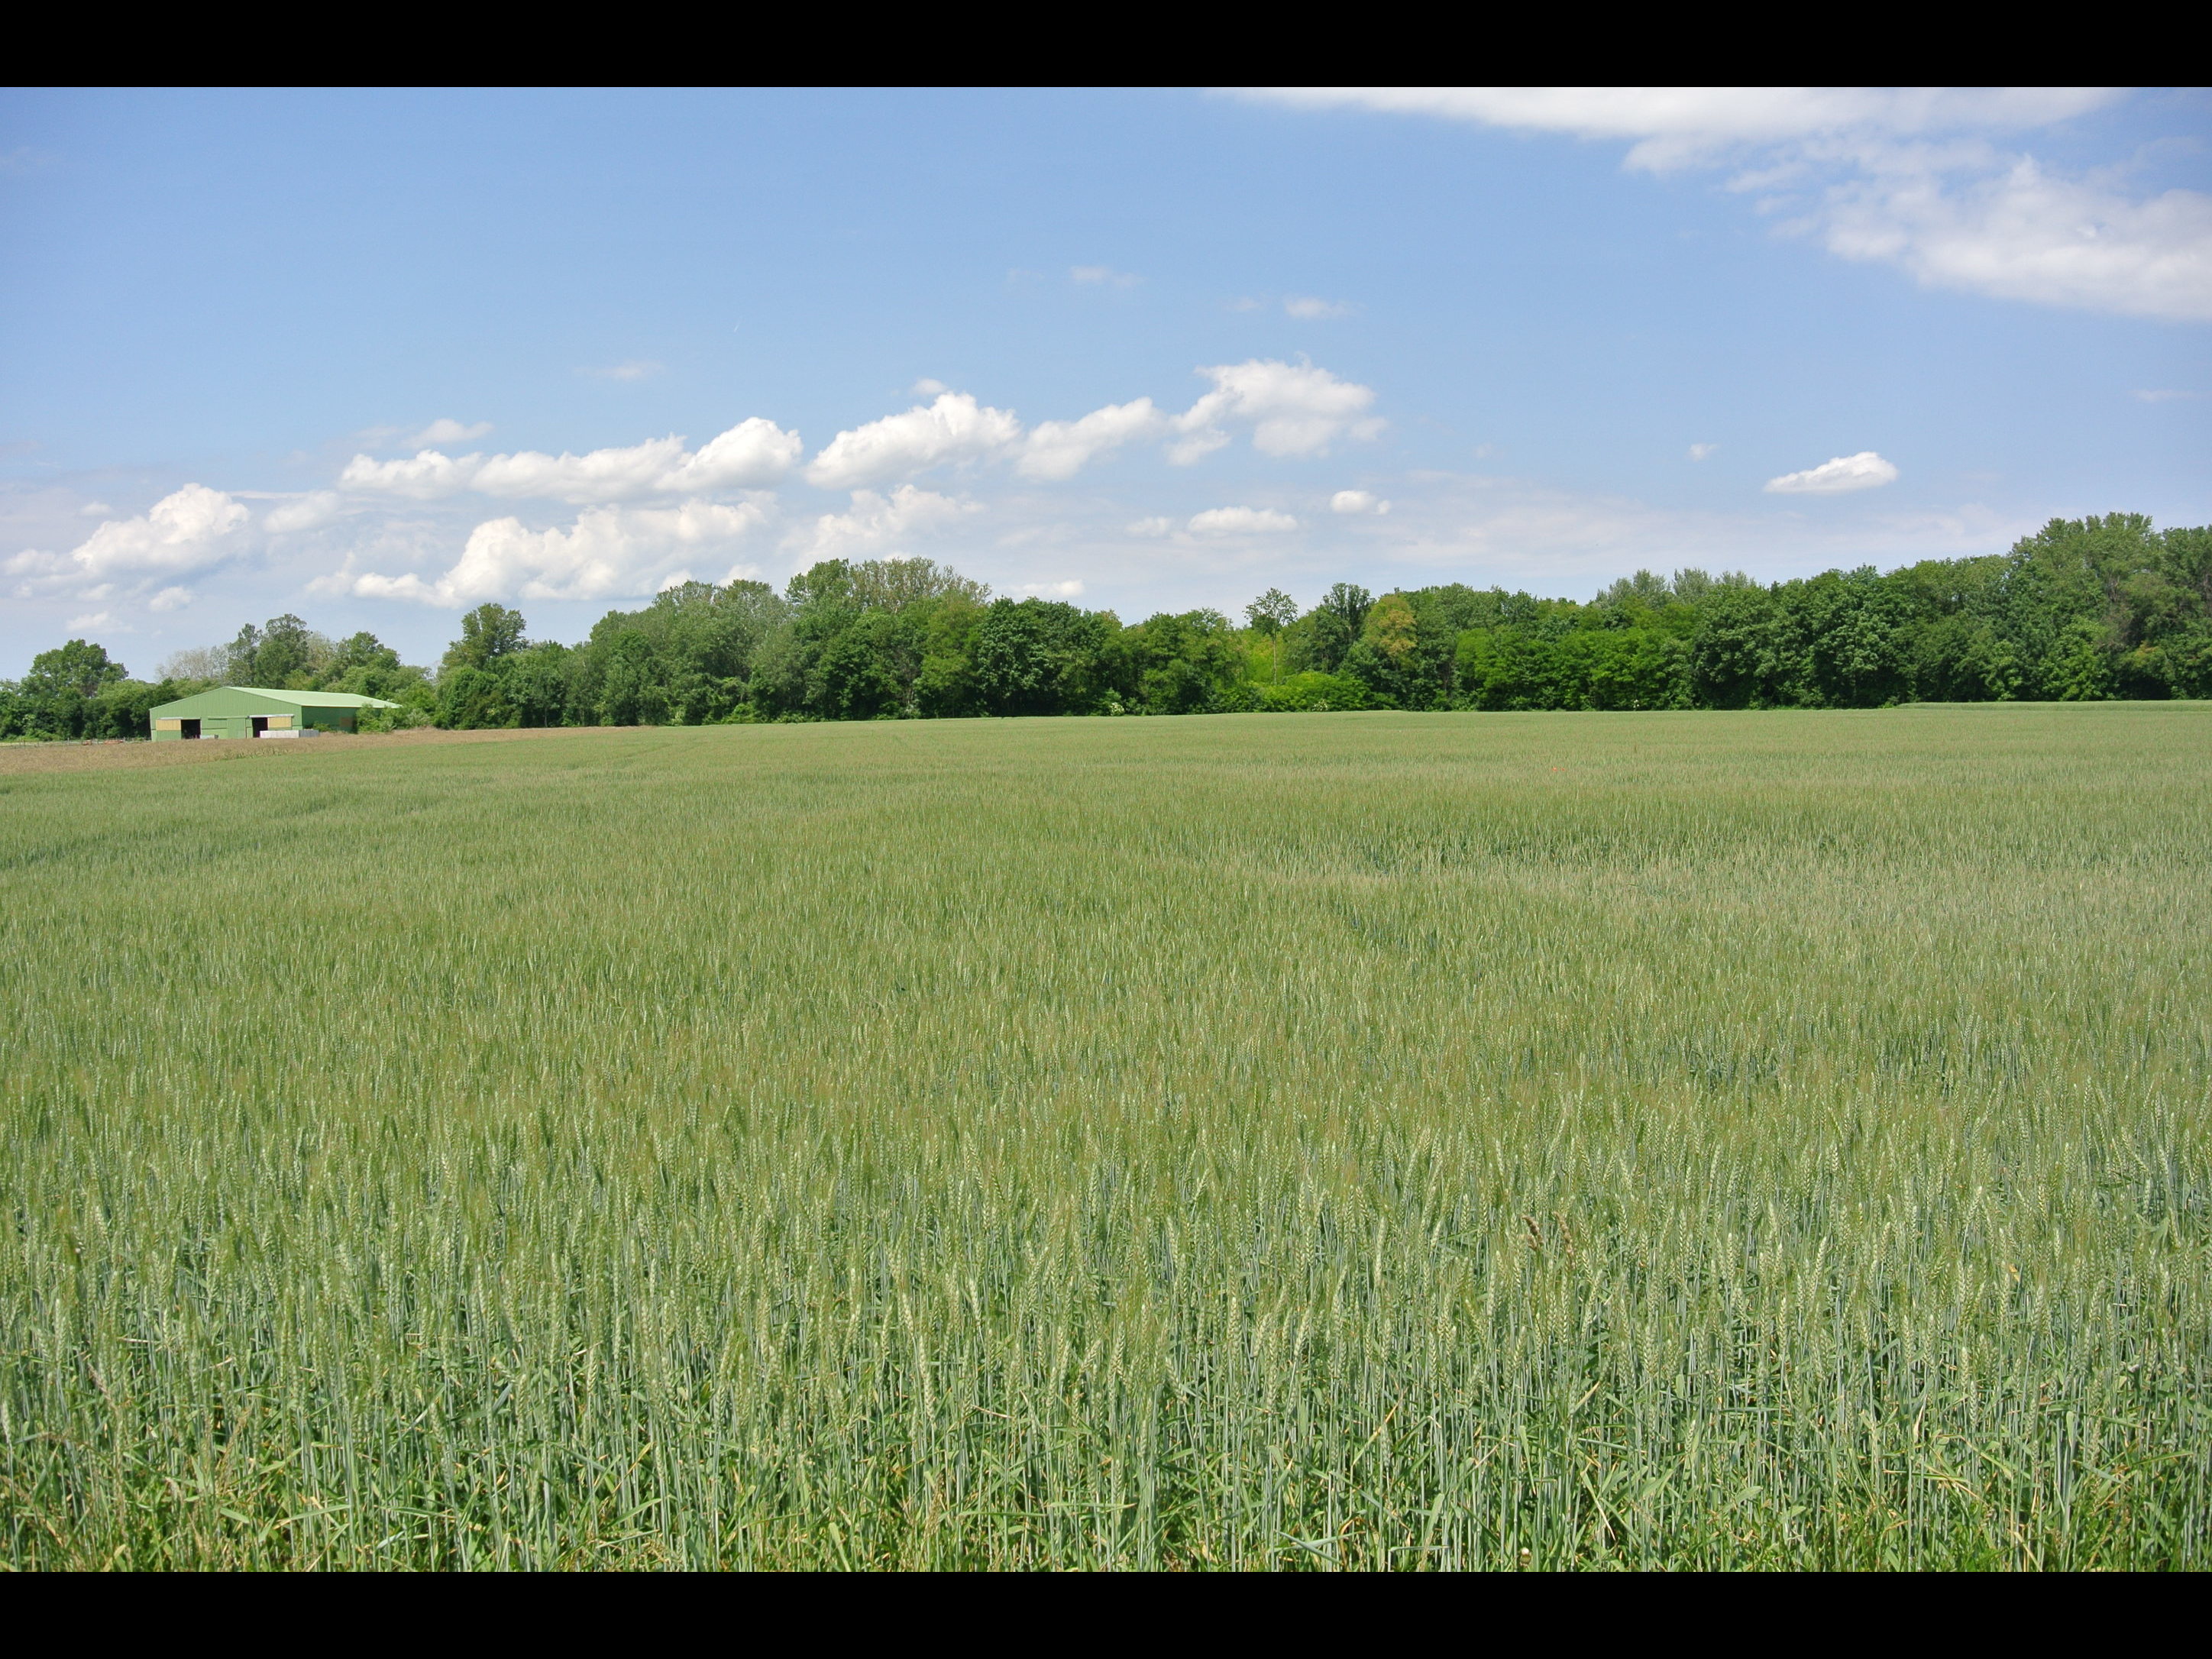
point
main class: Cropland
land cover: Triticale
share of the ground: > 75 %
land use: Agriculture (excluding fallow land and kitchen gardens)
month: June
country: AT
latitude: 47.9268
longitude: 16.4422
